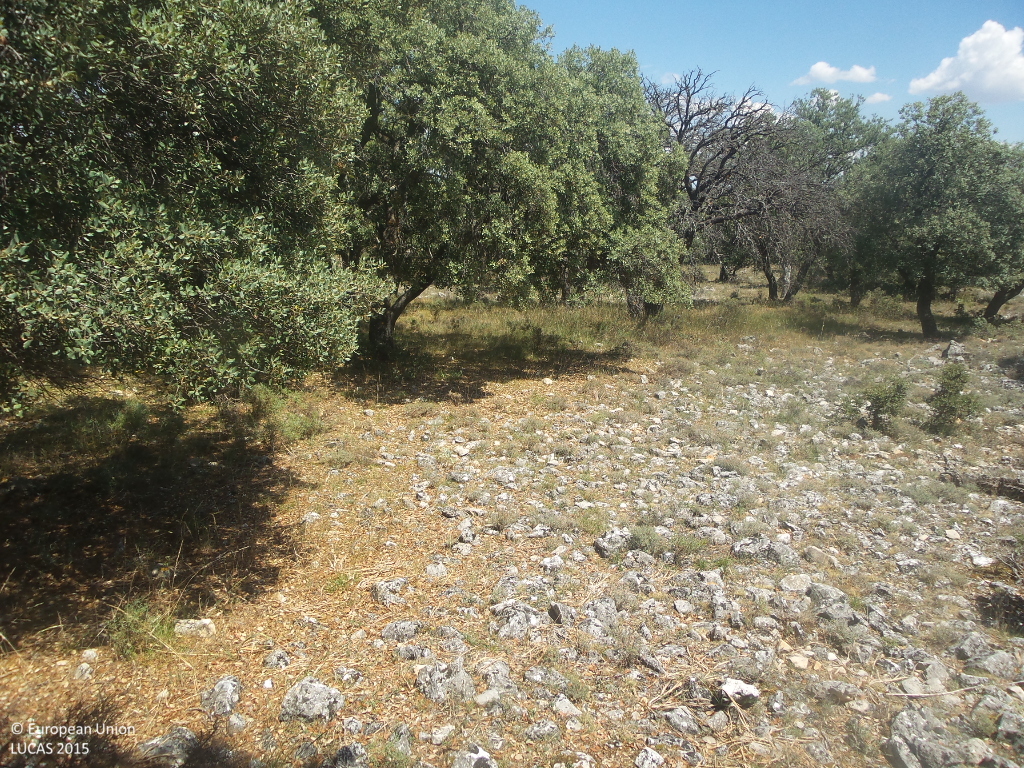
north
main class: Woodland
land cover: Broadleaved woodland
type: broadleaved evergreen forest
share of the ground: 50 - 75 %
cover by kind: broadleaved forest trees 60 %, unconsolidated bare surface 25 %, shrubs 5 %, herbaceous plants 5 %, lichens and mosses 5 %
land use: Semi-natural and natural areas not in use
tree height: > 5 m
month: June
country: ES
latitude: 41.4076
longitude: -3.0200
